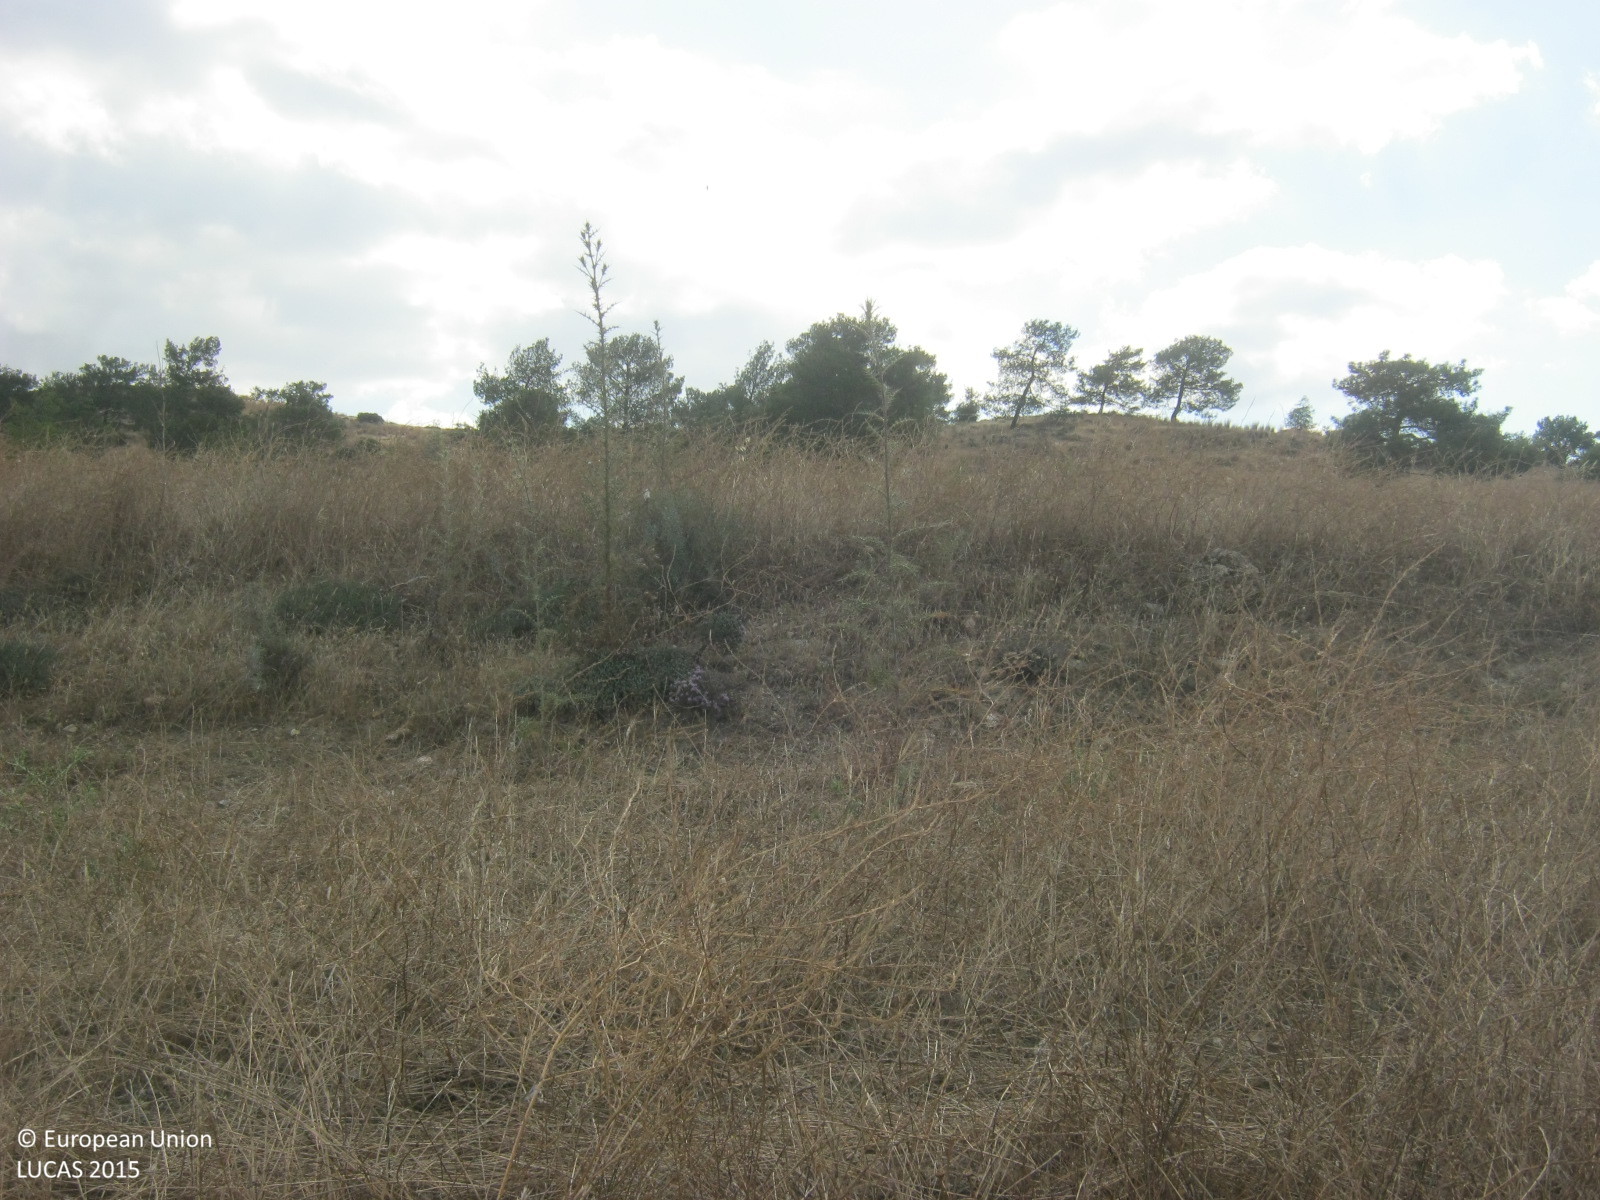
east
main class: Shrubland
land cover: Shrubland without tree cover
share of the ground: 10 - 25 %
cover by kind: herbaceous plants 80 %, shrubs 15 %, unconsolidated bare surface 5 %
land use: Semi-natural and natural areas not in use
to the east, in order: Shrubland without tree cover; Grassland without tree/shrub cover; Grassland with sparse tree/shrub cover; Grassland without tree/shrub cover
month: June
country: CY
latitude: 35.0744
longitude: 32.9295
